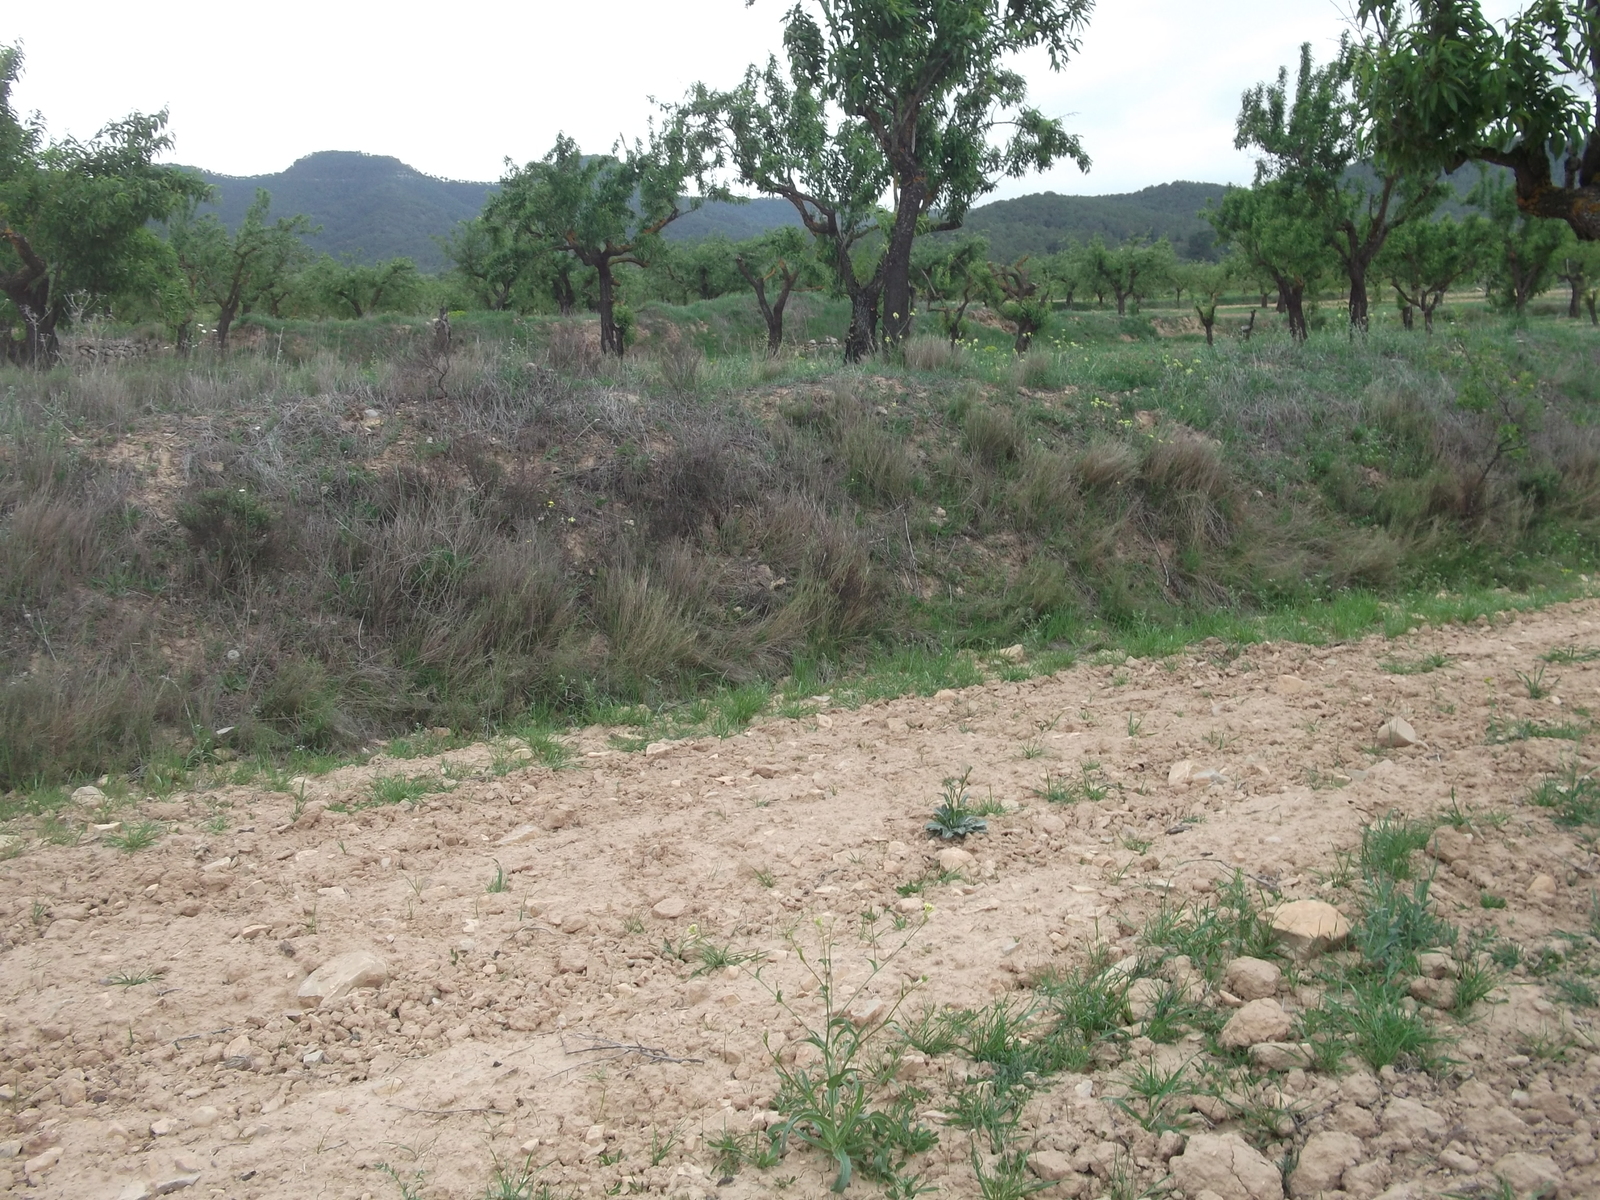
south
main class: Cropland
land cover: Nuts trees
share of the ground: 10 - 25 %
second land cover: Spontaneously vegetated surfaces
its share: 25 - 50 %
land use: Agriculture (excluding fallow land and kitchen gardens)
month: April
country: ES
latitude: 38.1478
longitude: -1.4784
